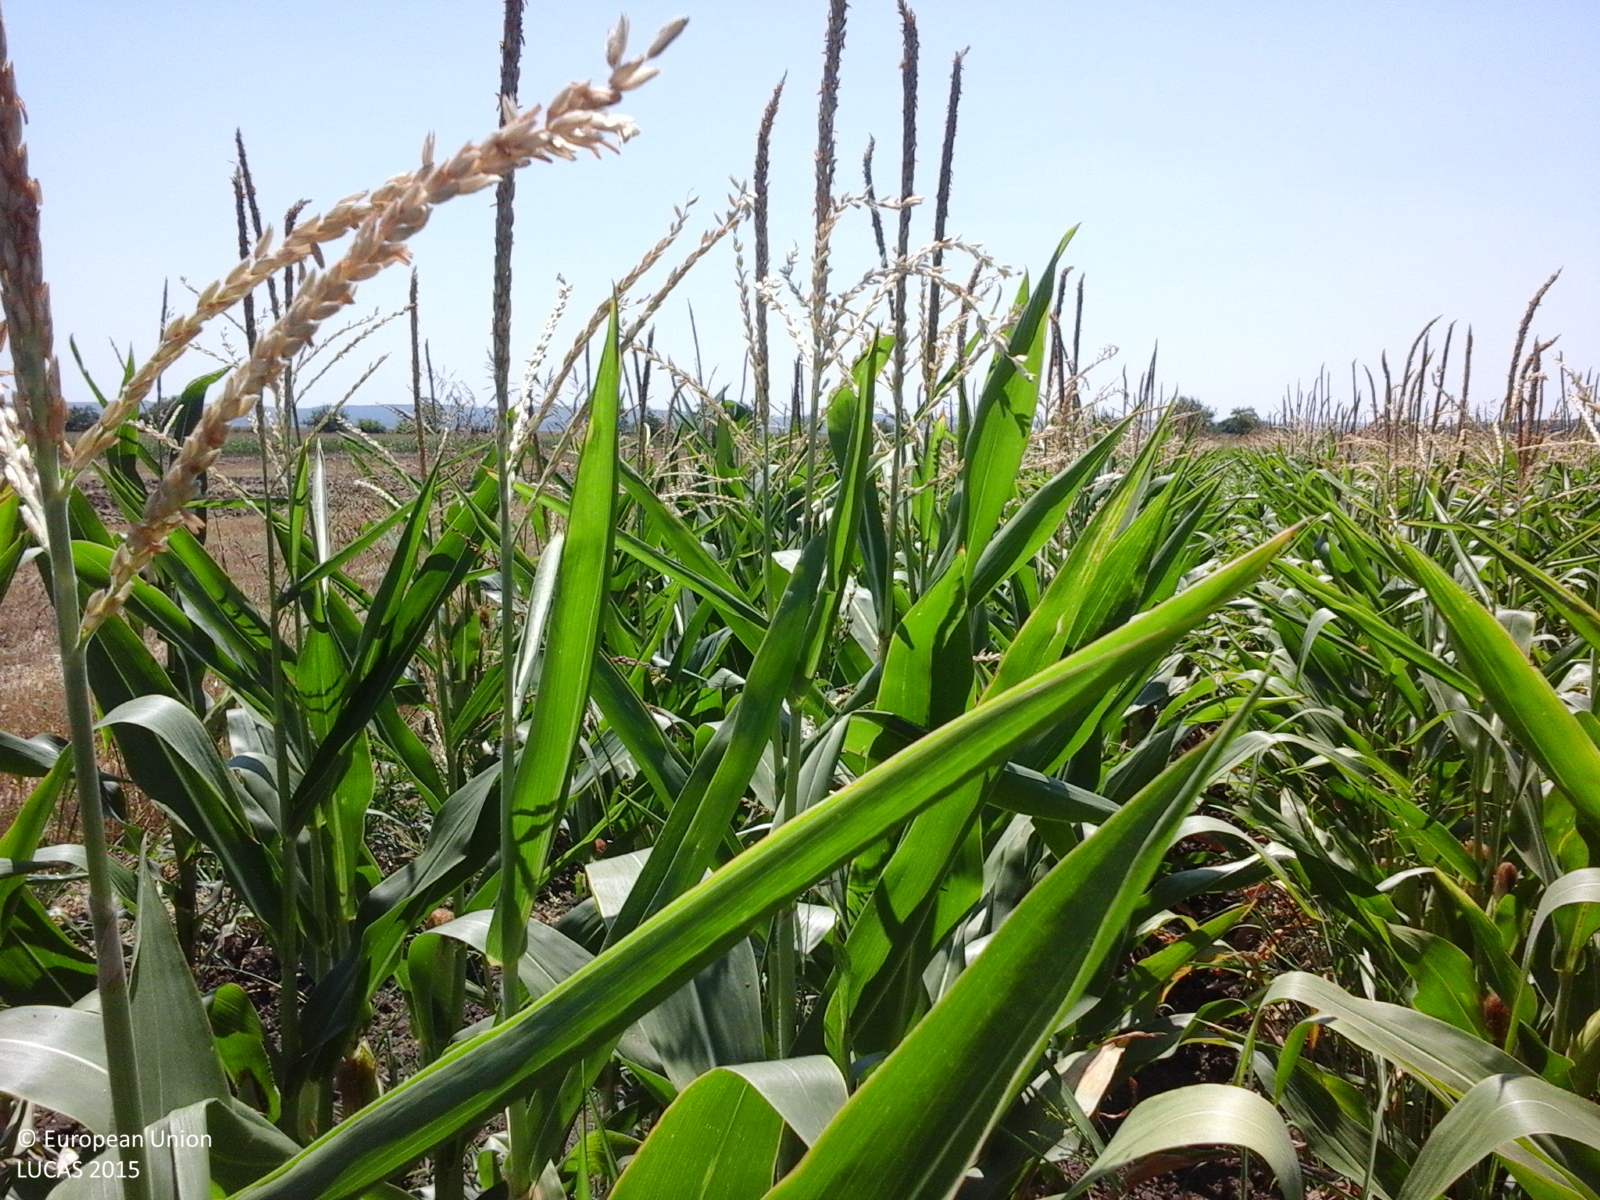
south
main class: Cropland
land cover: Maize
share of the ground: > 75 %
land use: Agriculture (excluding fallow land and kitchen gardens)
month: July
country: RO
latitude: 44.2037
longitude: 27.0069
